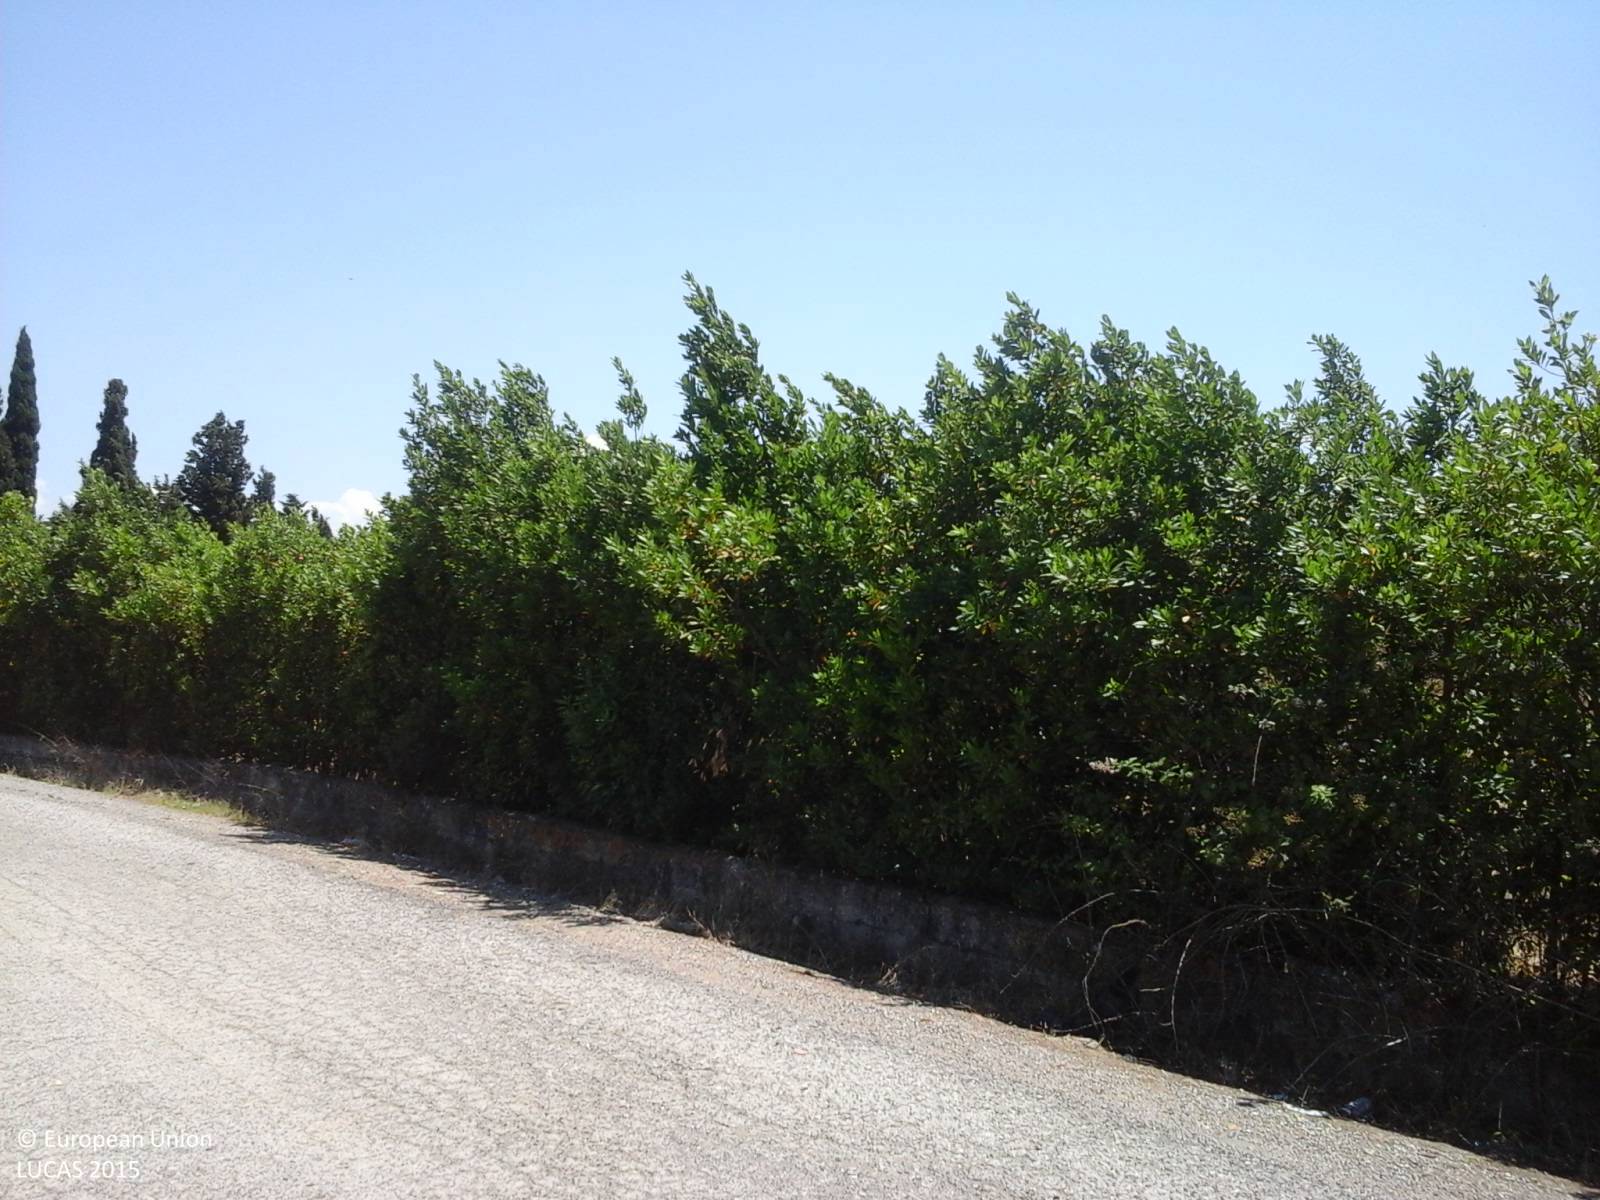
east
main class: Grassland
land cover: Grassland without tree/shrub cover
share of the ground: > 75 %
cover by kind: herbaceous plants 100 %
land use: Agriculture (excluding fallow land and kitchen gardens)
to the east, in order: Grassland without tree/shrub cover; Fences; Grass margins; Ditches and canals; Artificial constructions in urban areas
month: June
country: IT
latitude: 39.3375
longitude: 8.9045
